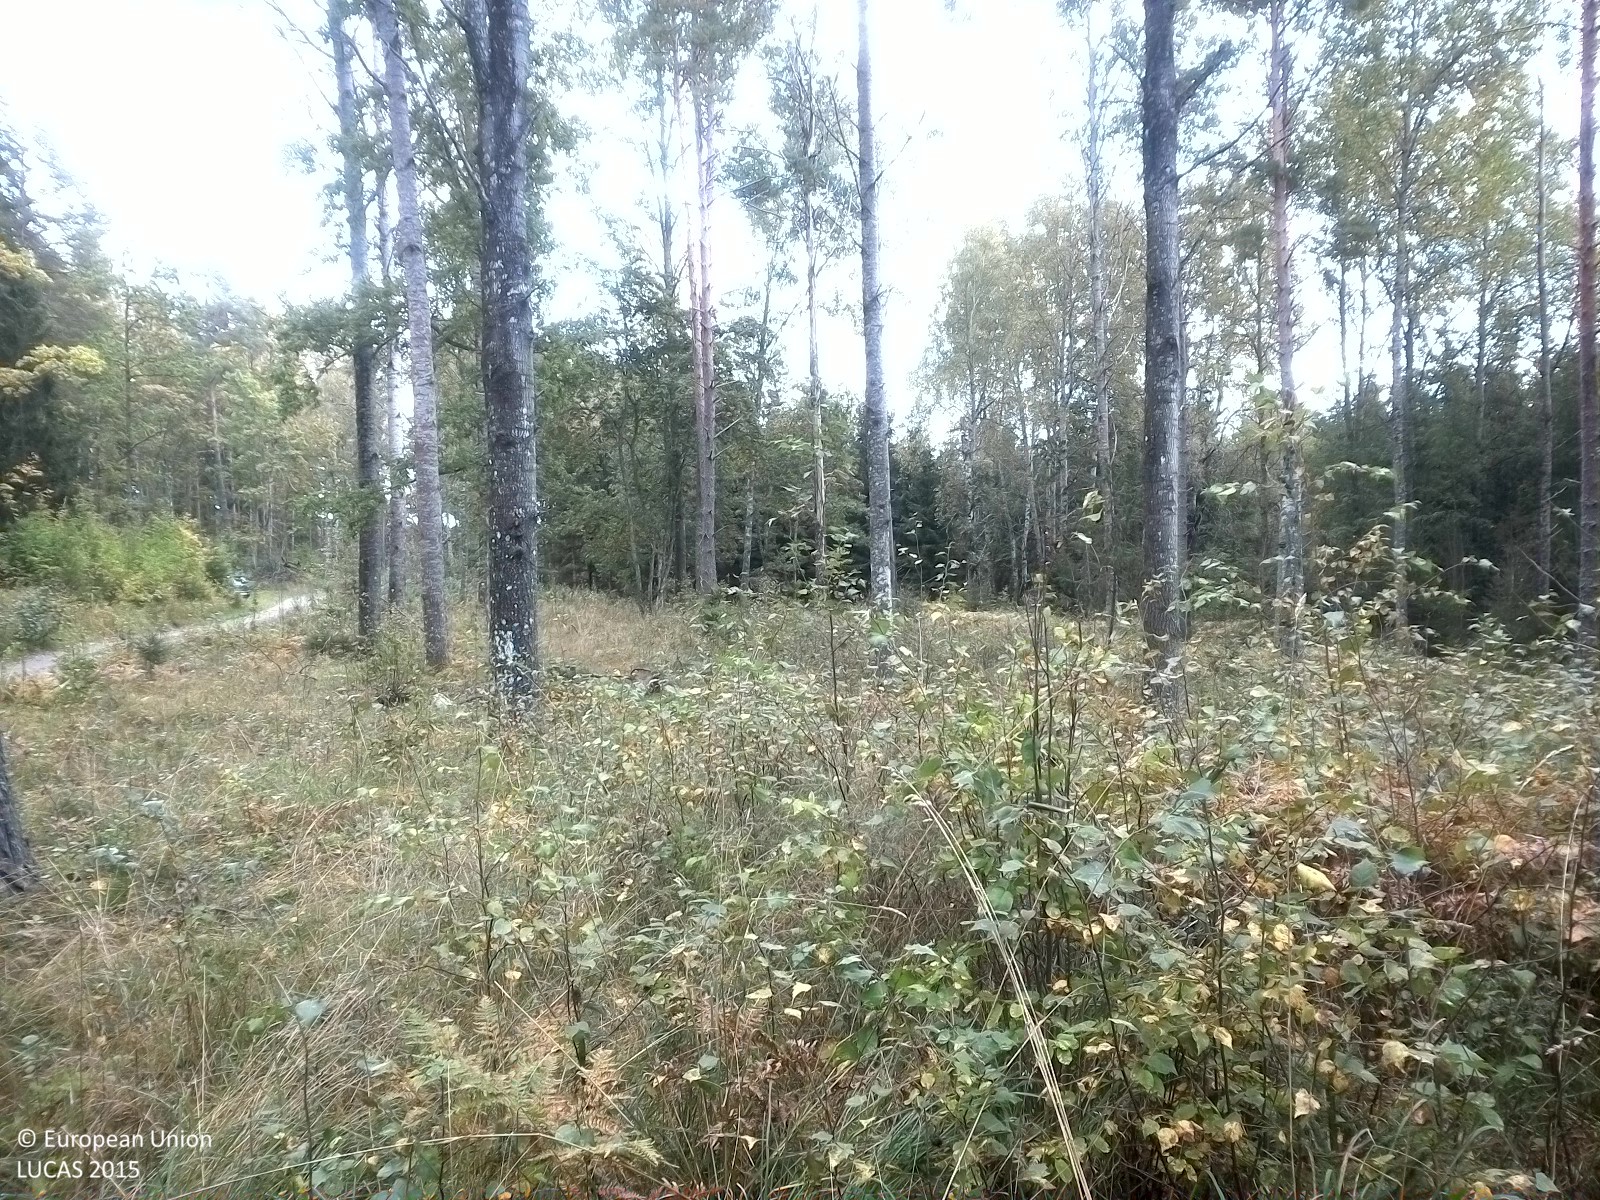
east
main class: Woodland
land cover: Pine dominated mixed woodland
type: boreal forest
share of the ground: 25 - 50 %
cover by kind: herbaceous plants 45 %, coniferous forest trees 25 %, broadleaved forest trees 15 %, shrubs 10 %, lichens and mosses 5 %
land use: Forestry
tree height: > 5 m
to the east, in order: Pine dominated mixed woodland; Broadleaved woodland; Spruce dominated coniferous woodland; Broadleaved woodland
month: September
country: SE
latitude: 58.9223
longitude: 15.8465
